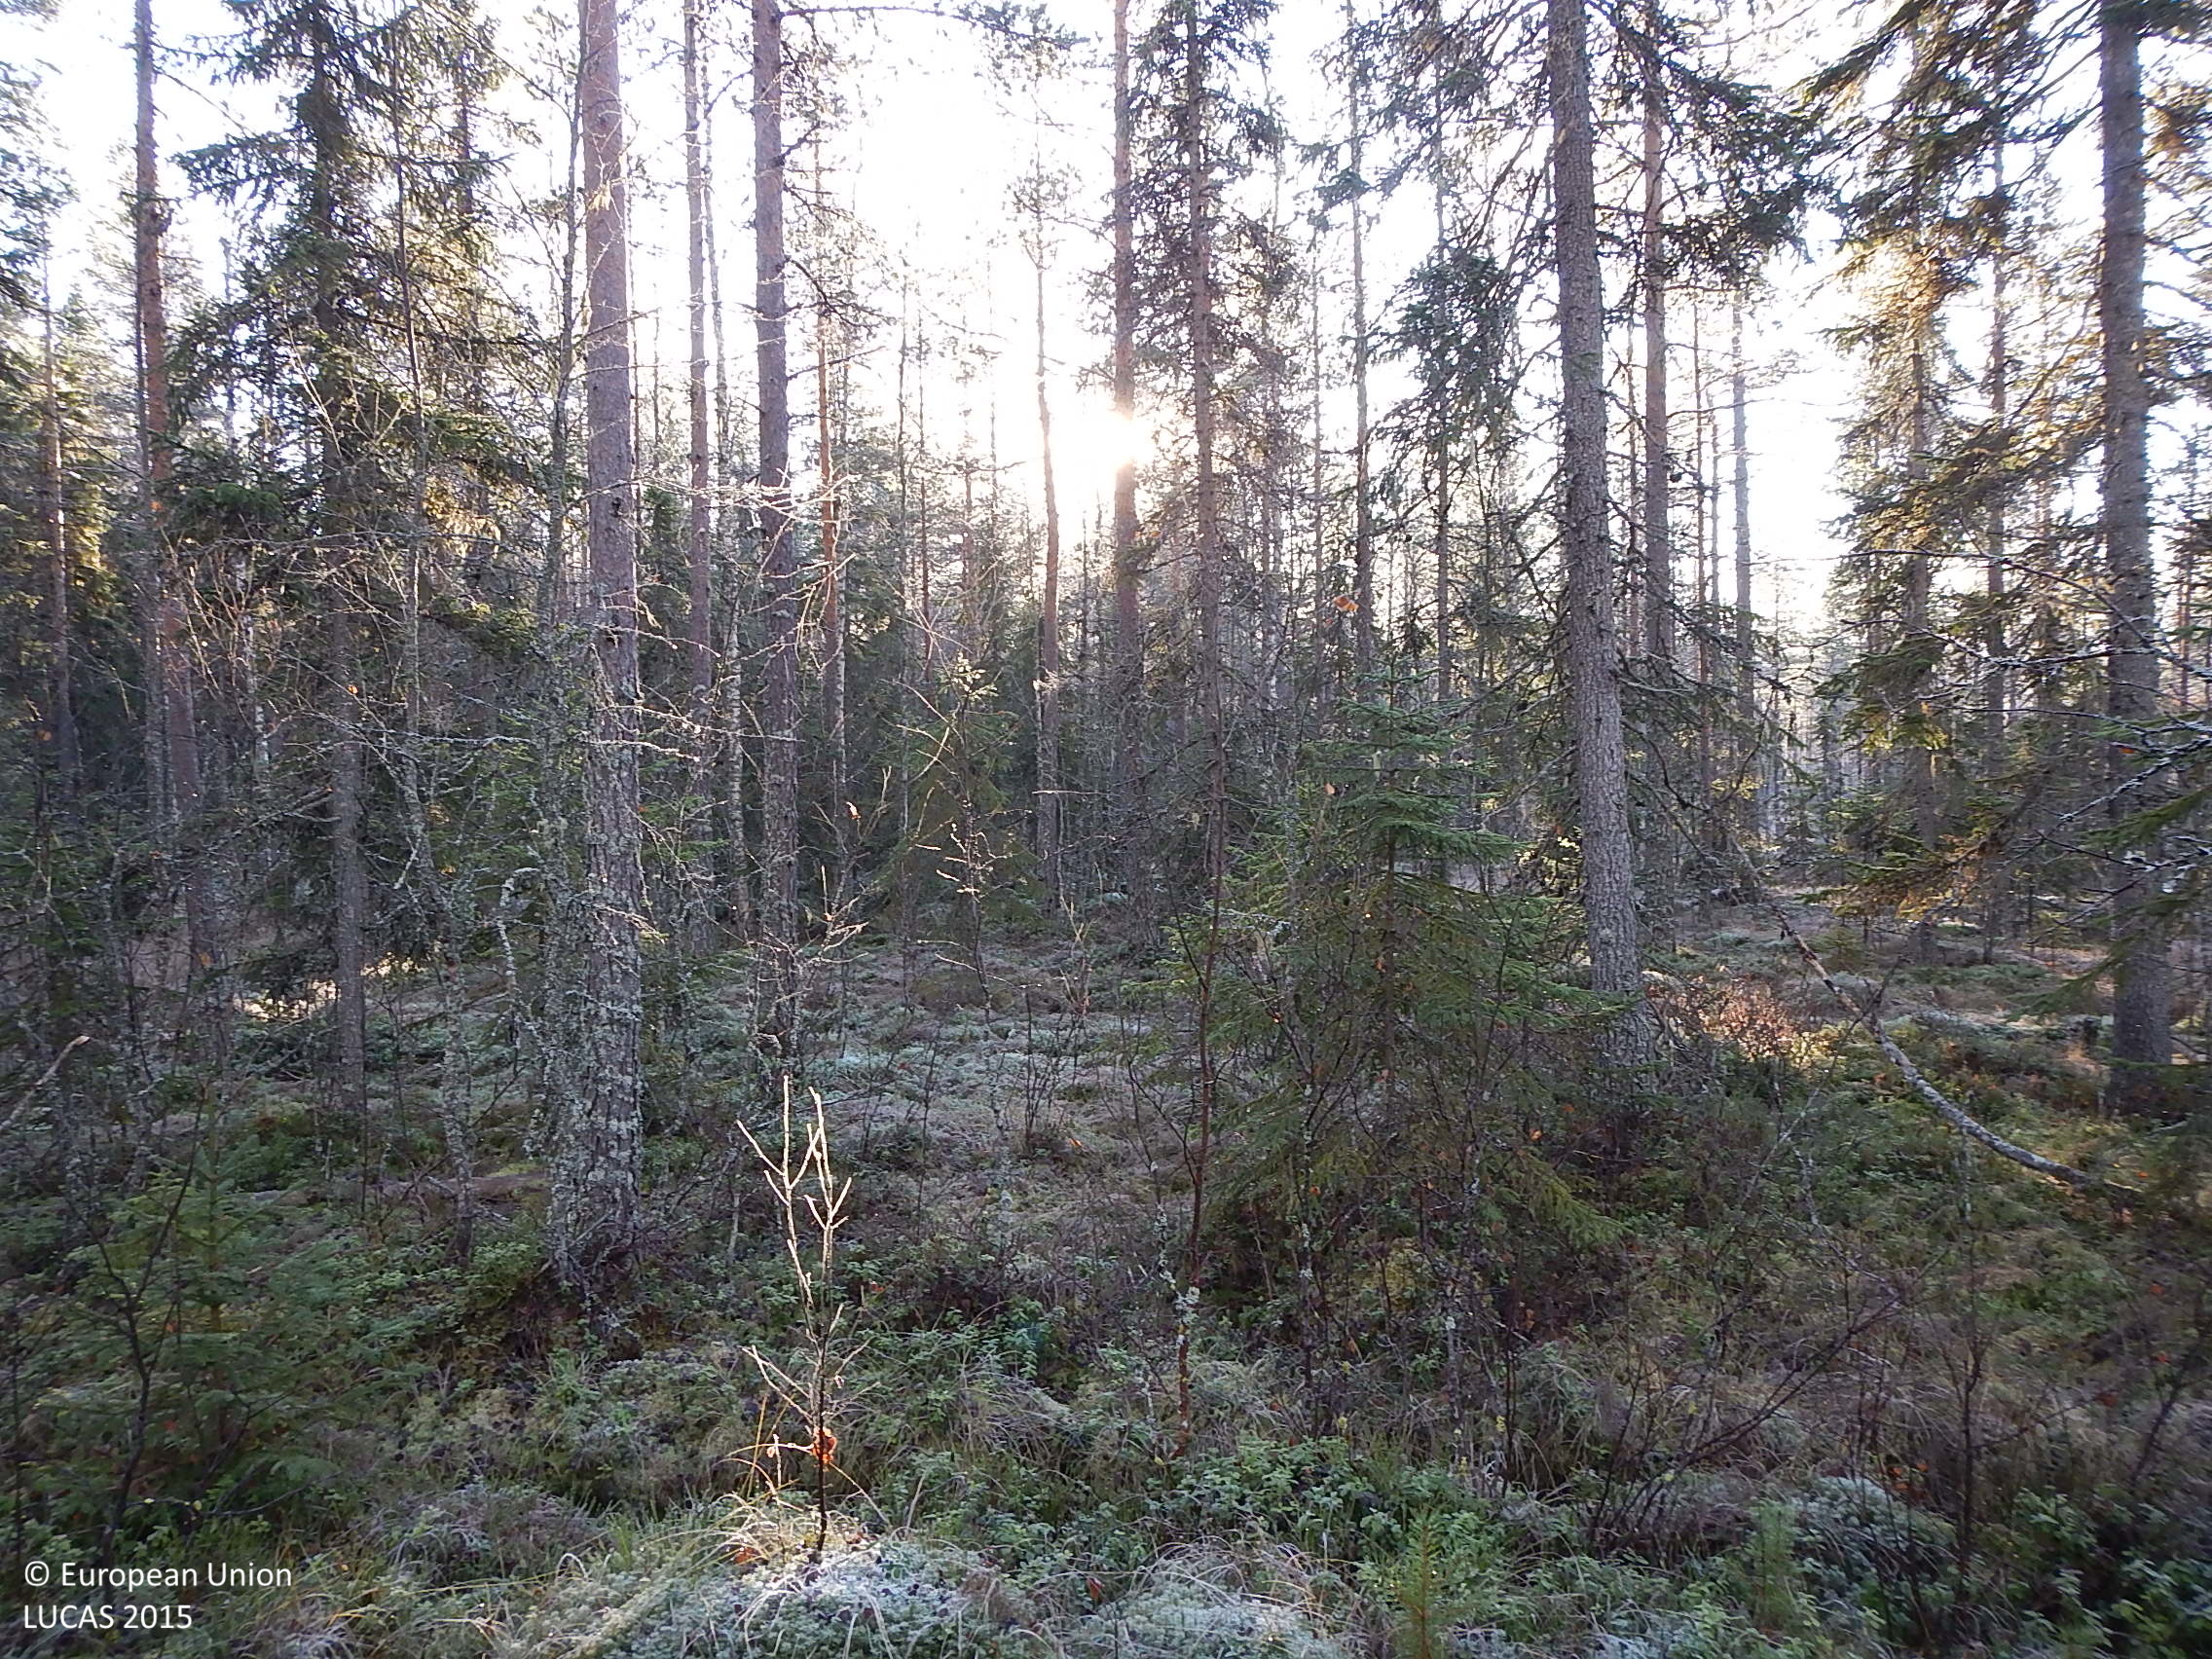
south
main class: Woodland
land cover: Pine dominated coniferous woodland
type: mire and swamp forests
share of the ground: 50 - 75 %
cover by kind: coniferous forest trees 60 %, shrubs 25 %, lichens and mosses 10 %, broadleaved forest trees 5 %
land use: Forestry
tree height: > 5 m
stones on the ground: < 10 %
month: November
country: SE
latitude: 61.5726
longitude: 15.9528
